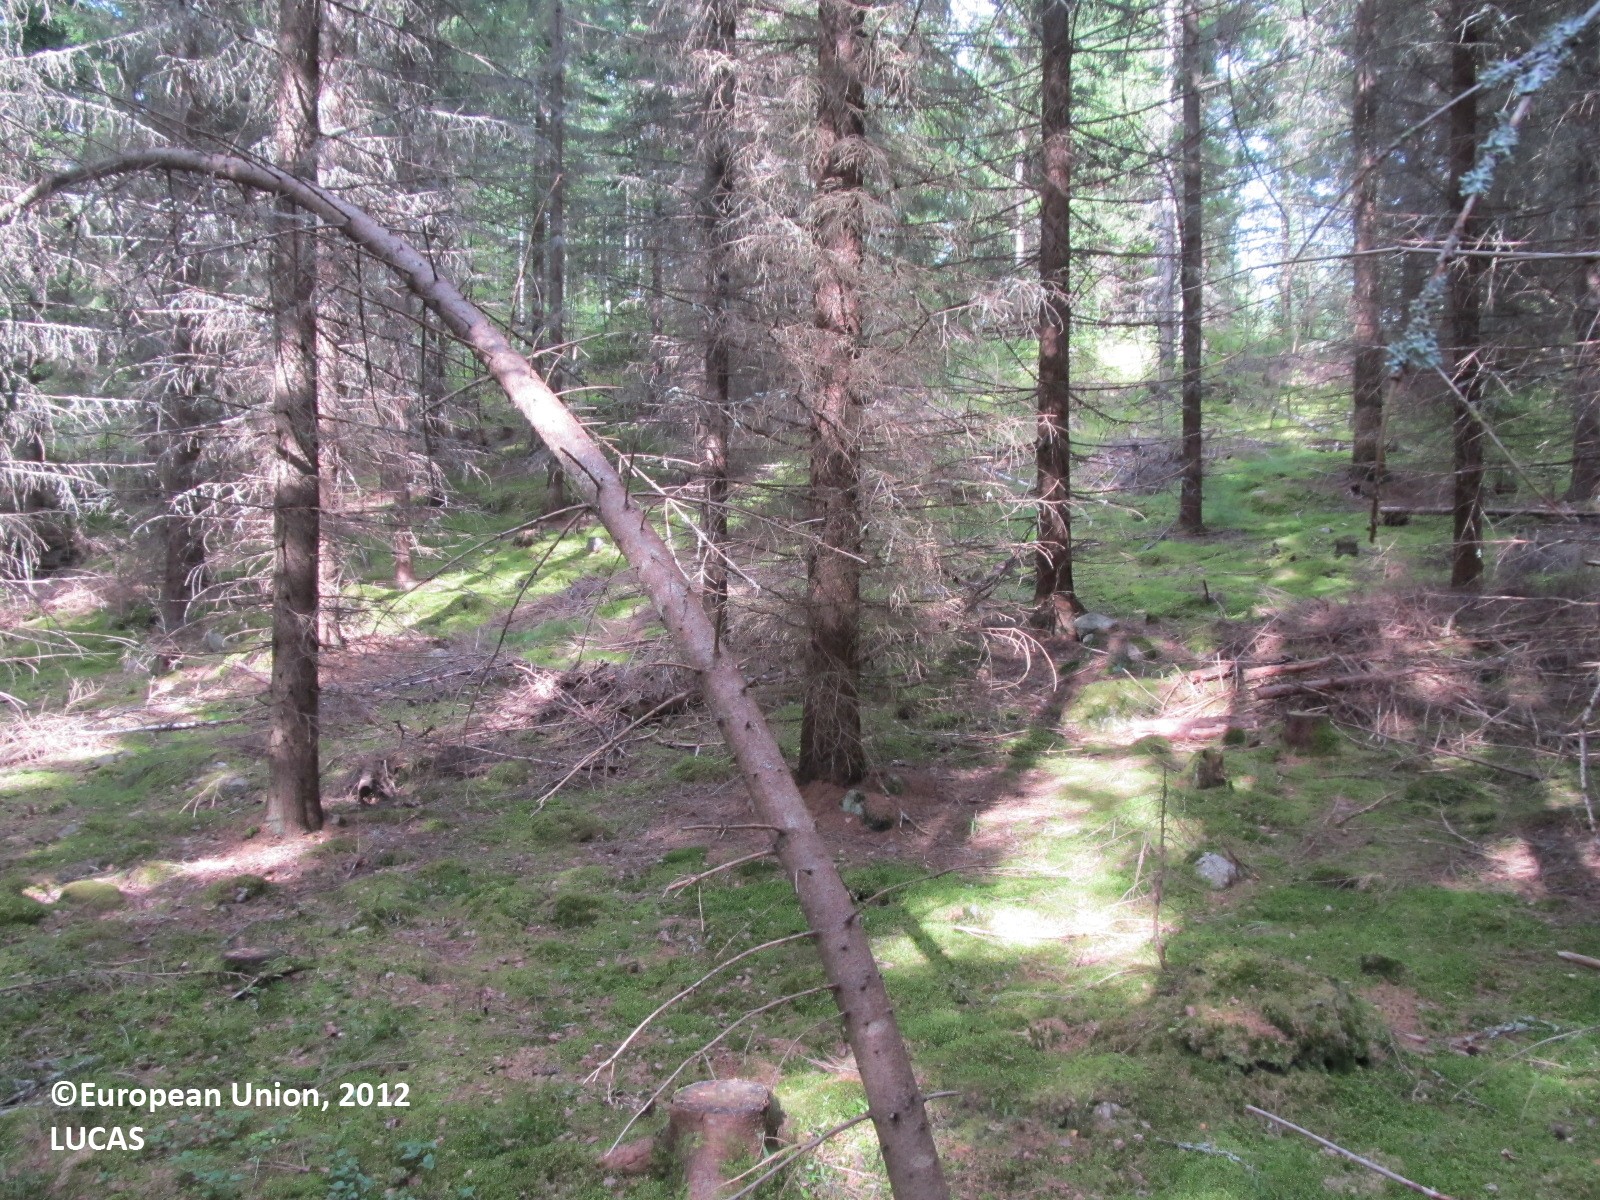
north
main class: Woodland
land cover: Spruce dominated coniferous woodland
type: boreal forest
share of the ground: 50 - 75 %
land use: Forestry
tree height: > 5 m
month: August
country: FI
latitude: 61.6625
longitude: 27.6888
